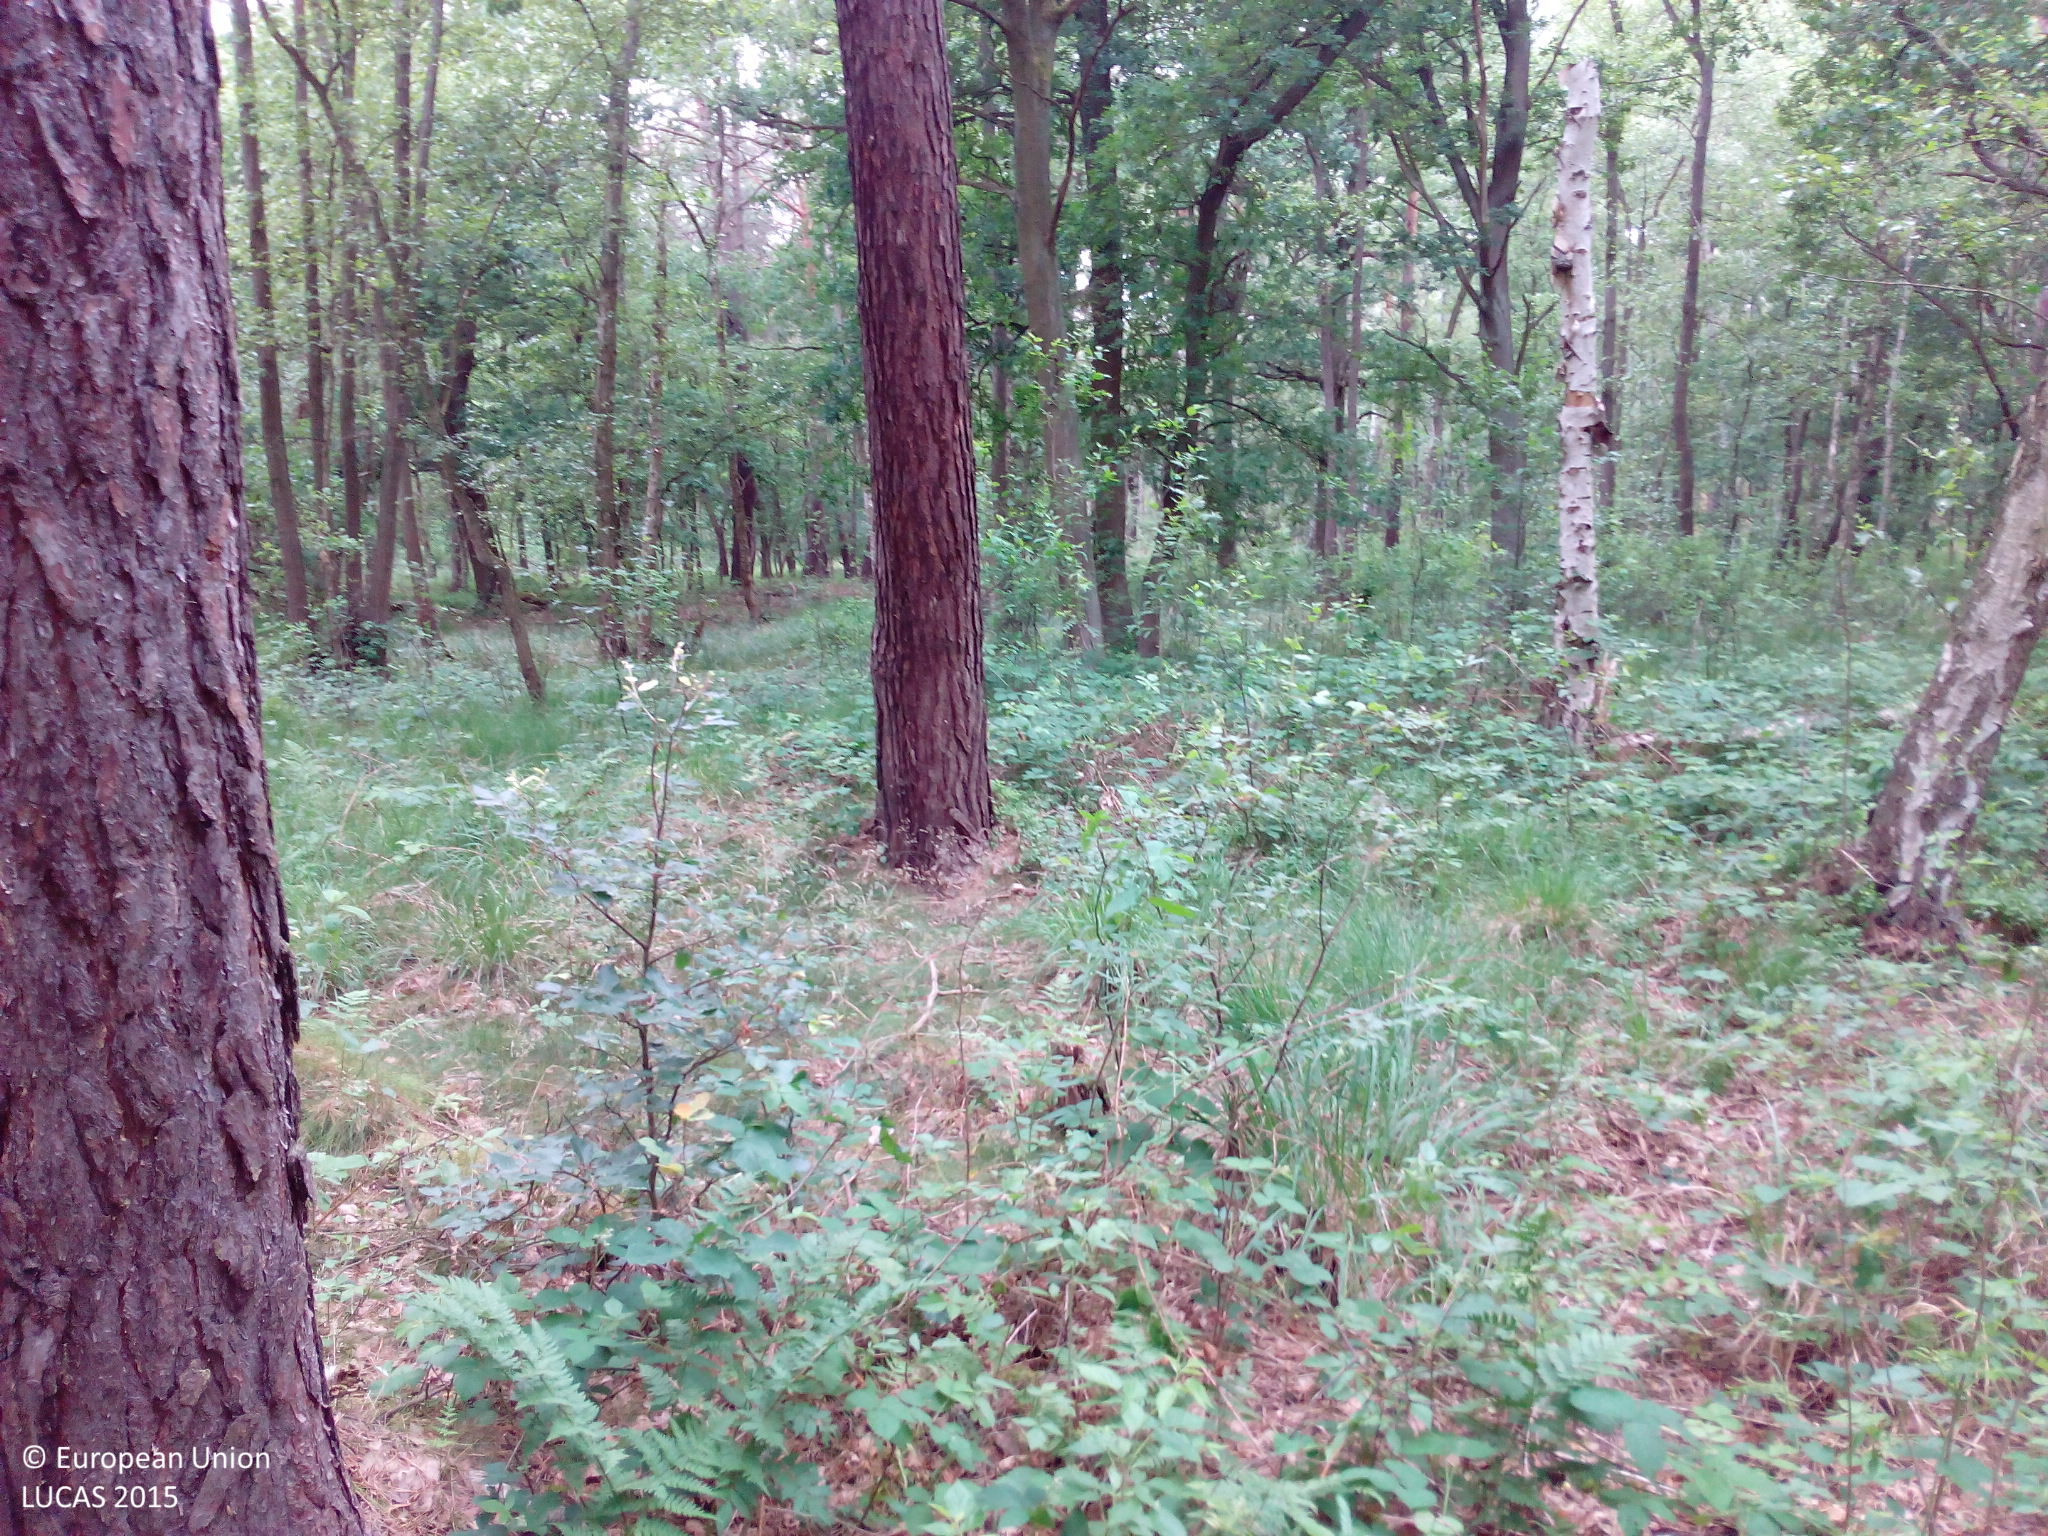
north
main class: Woodland
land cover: Broadleaved woodland
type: mesophytic deciduous forest
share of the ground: > 75 %
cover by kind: broadleaved forest trees 60 %, coniferous forest trees 20 %, shrubs 15 %, lichens and mosses 5 %
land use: Forestry
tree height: > 5 m
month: June
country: DE
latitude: 52.5498
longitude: 12.4624
